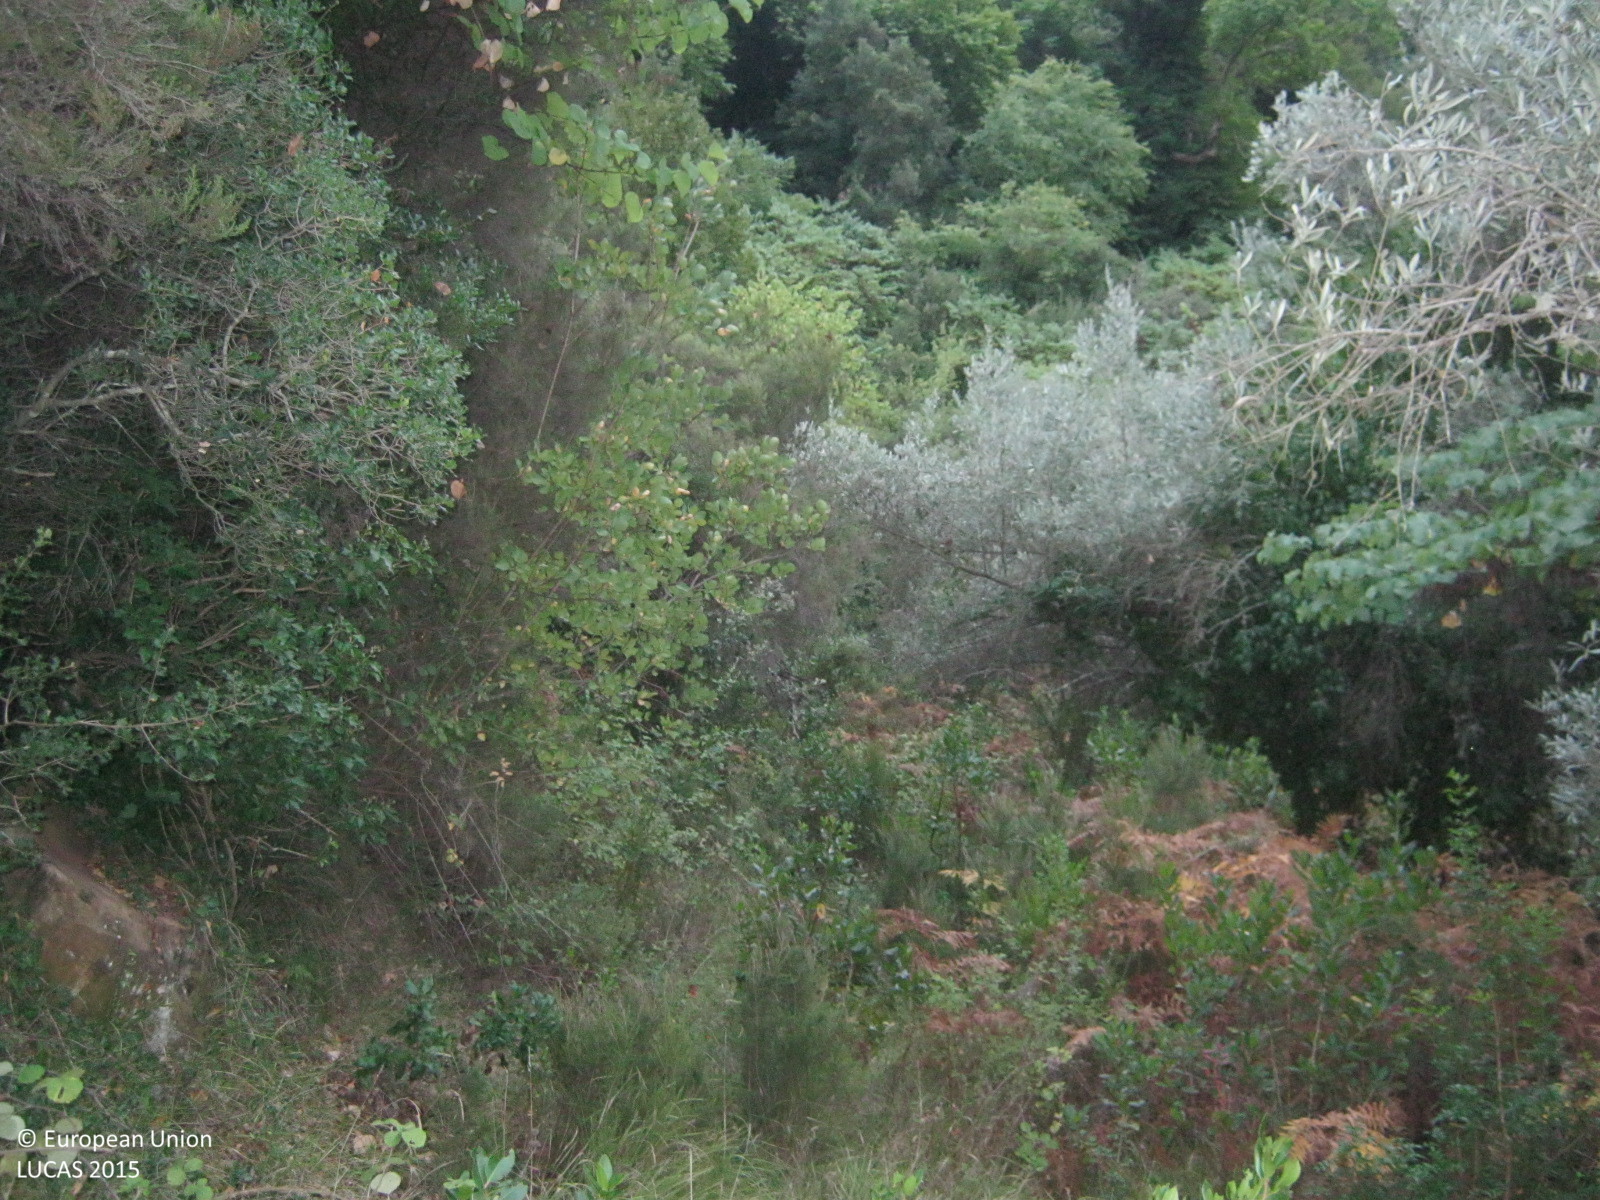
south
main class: Cropland
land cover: Olive groves
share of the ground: > 75 %
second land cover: Spontaneously vegetated surfaces
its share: > 75 %
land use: Agriculture (excluding fallow land and kitchen gardens)
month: September
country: GR
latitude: 39.1639
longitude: 21.0732
